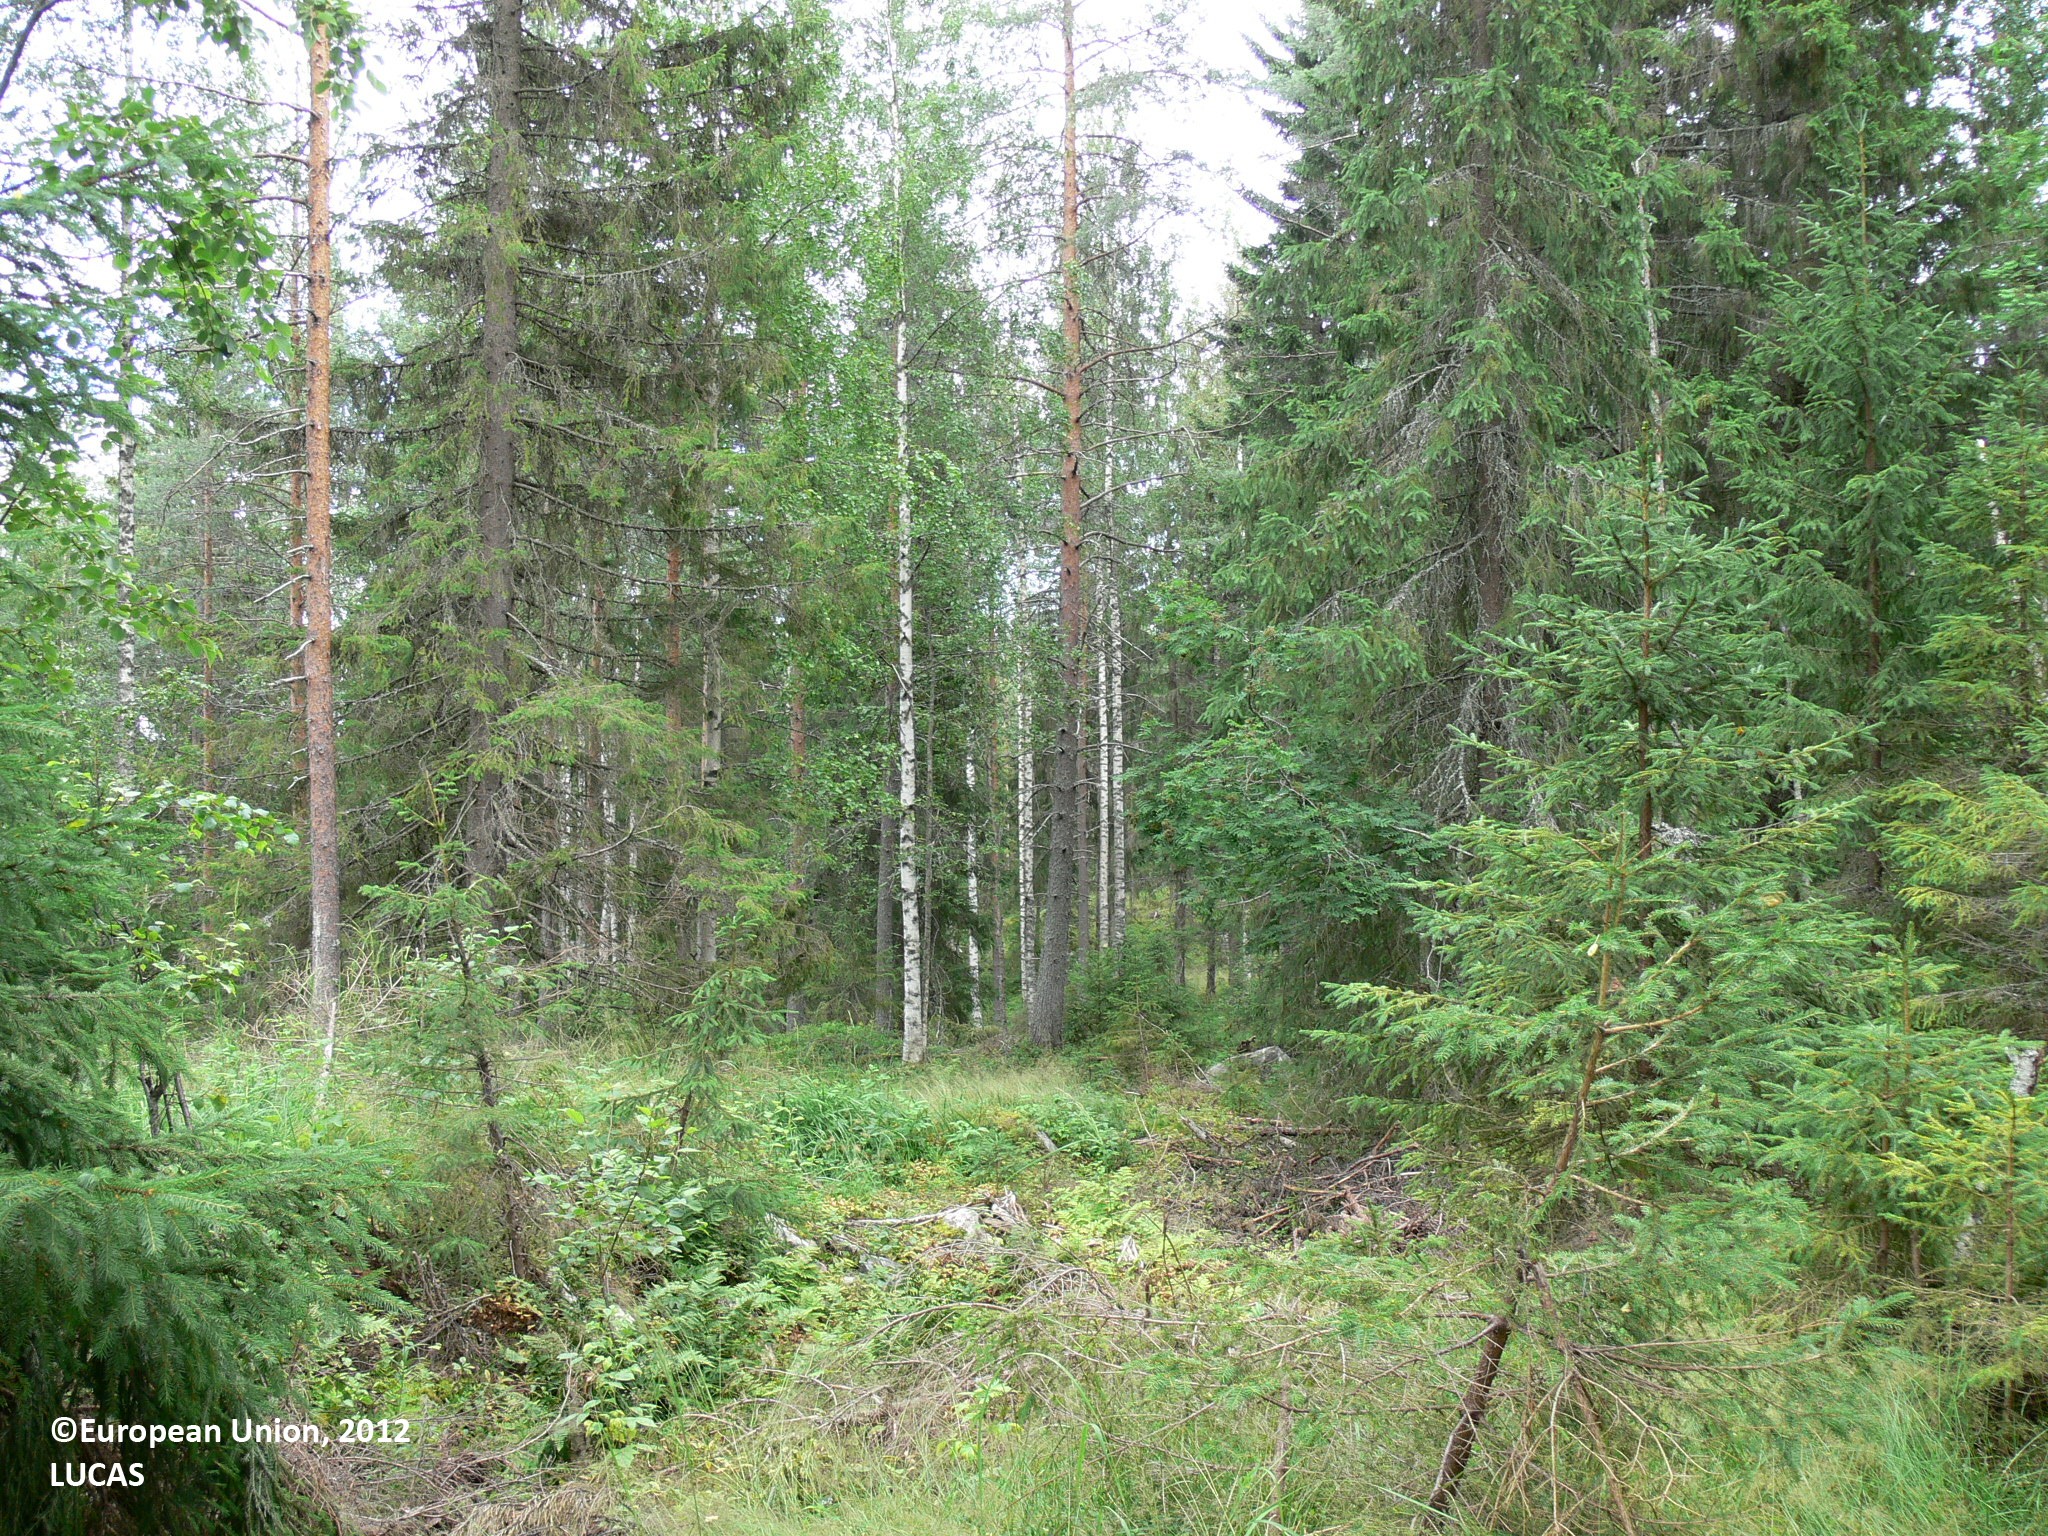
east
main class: Woodland
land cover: Other mixed woodland
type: boreal forest
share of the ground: 50 - 75 %
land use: Forestry
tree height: > 5 m
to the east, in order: Other mixed woodland; Pine dominated coniferous woodland; Other mixed woodland; Ditches and canals; Tracks; Other coniferous woodland; Pine dominated mixed woodland
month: July
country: FI
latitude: 63.1808
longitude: 29.3984
